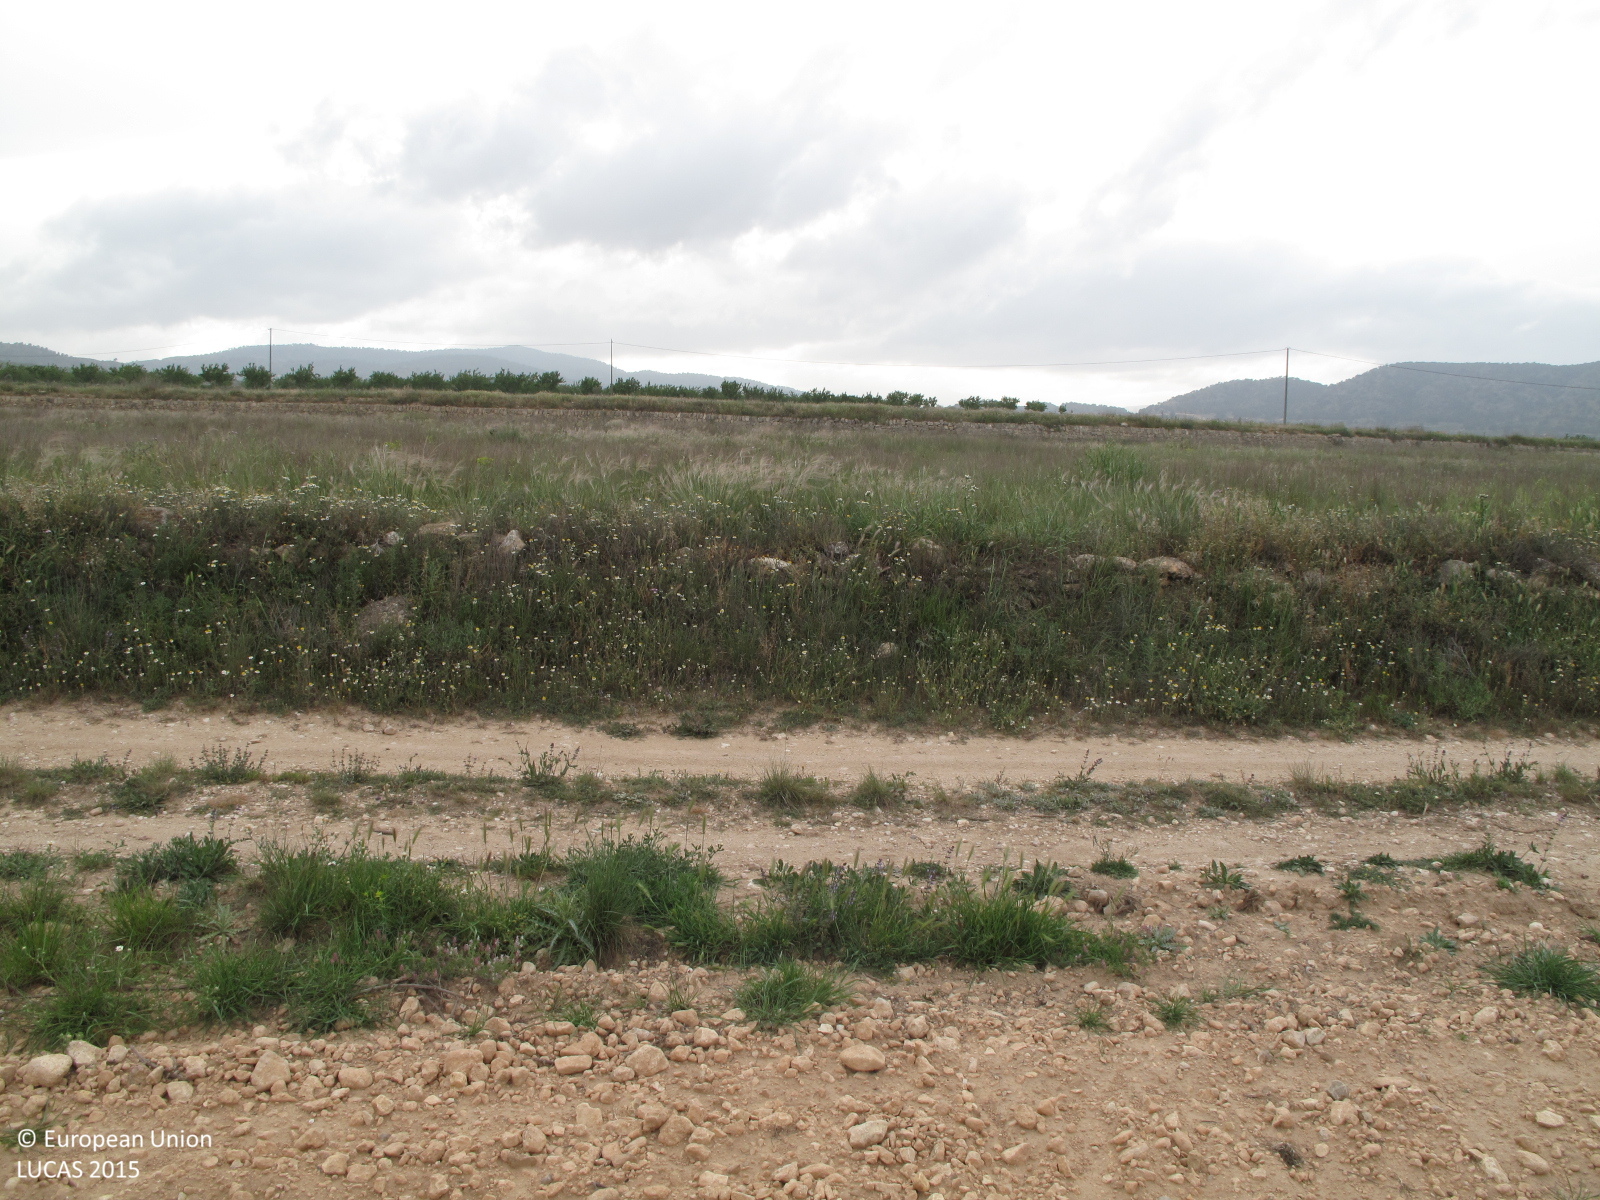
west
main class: Cropland
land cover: Vineyards
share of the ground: < 10 %
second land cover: Nuts trees
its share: < 10 %
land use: Agriculture (excluding fallow land and kitchen gardens)
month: April
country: ES
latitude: 38.4139
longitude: -0.9254
